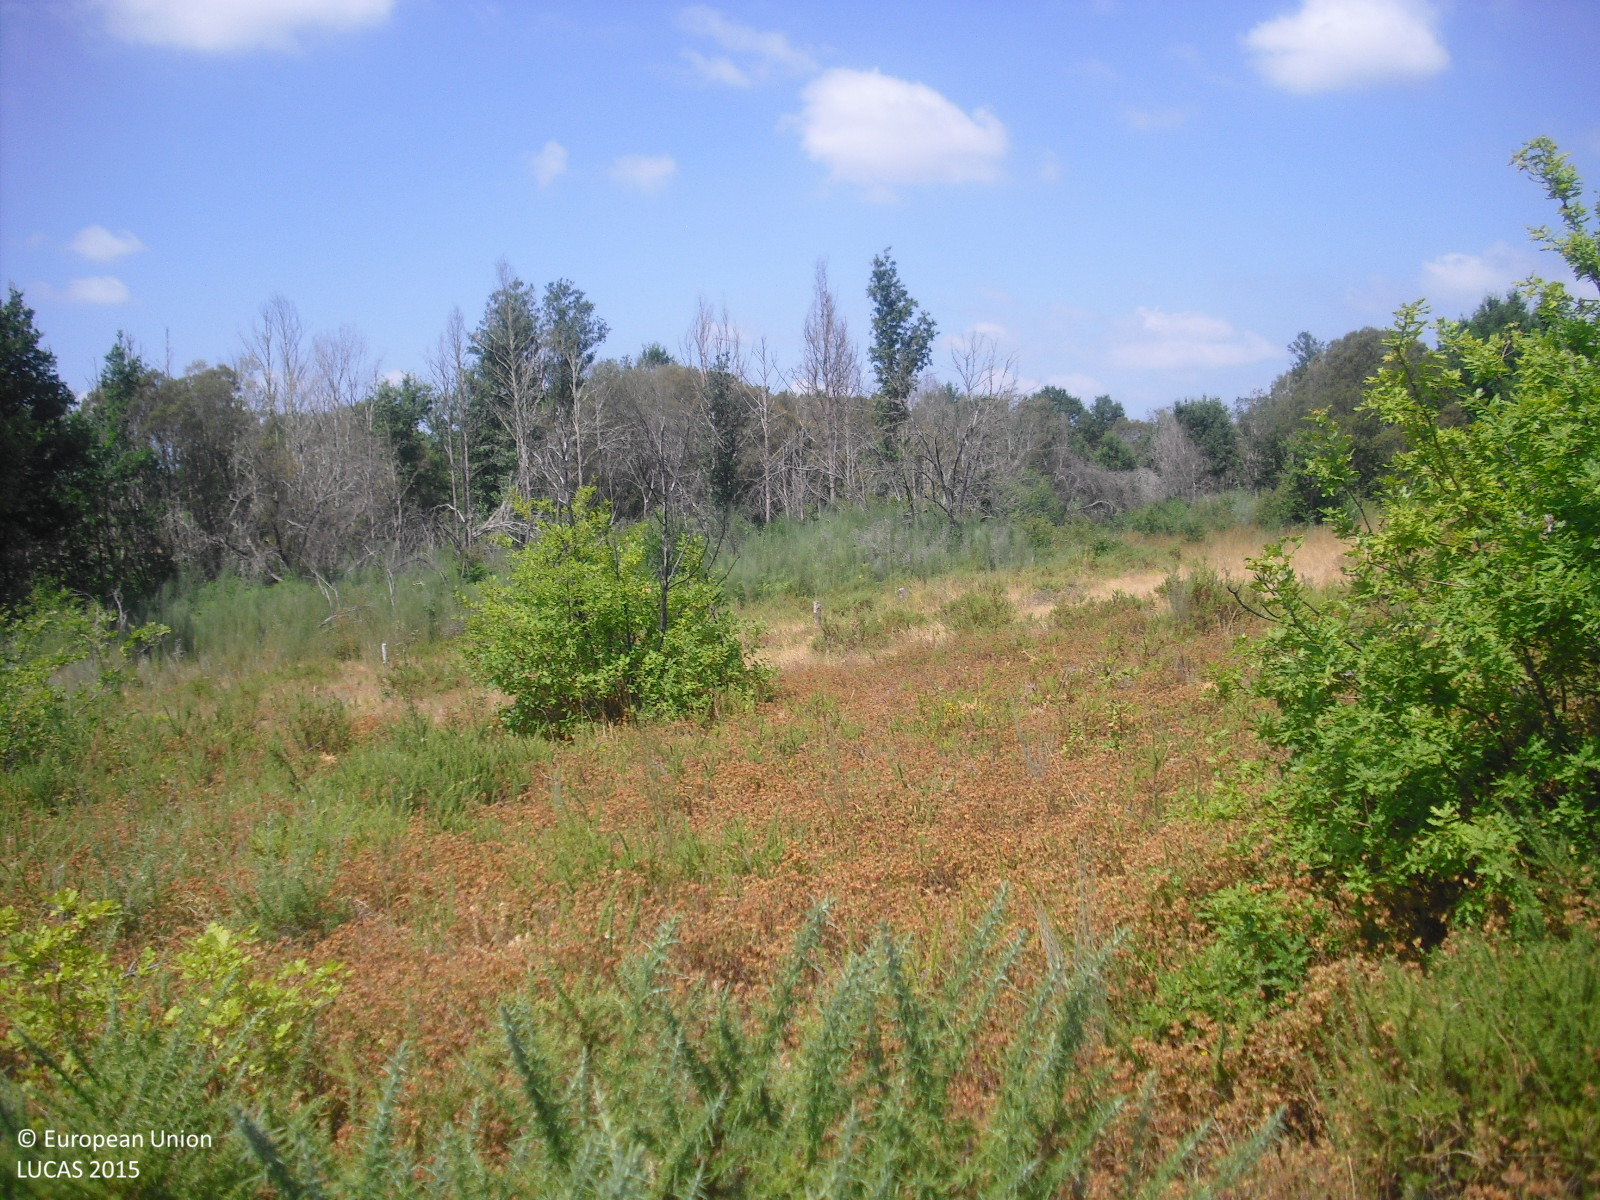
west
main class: Shrubland
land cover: Shrubland with sparse tree cover
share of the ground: > 75 %
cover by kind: shrubs 80 %, herbaceous plants 15 %, broadleaved forest trees 5 %
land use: Abandoned areas
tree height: < 5 m
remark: Burnt area
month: July
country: ES
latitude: 42.3600
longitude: -7.7647
